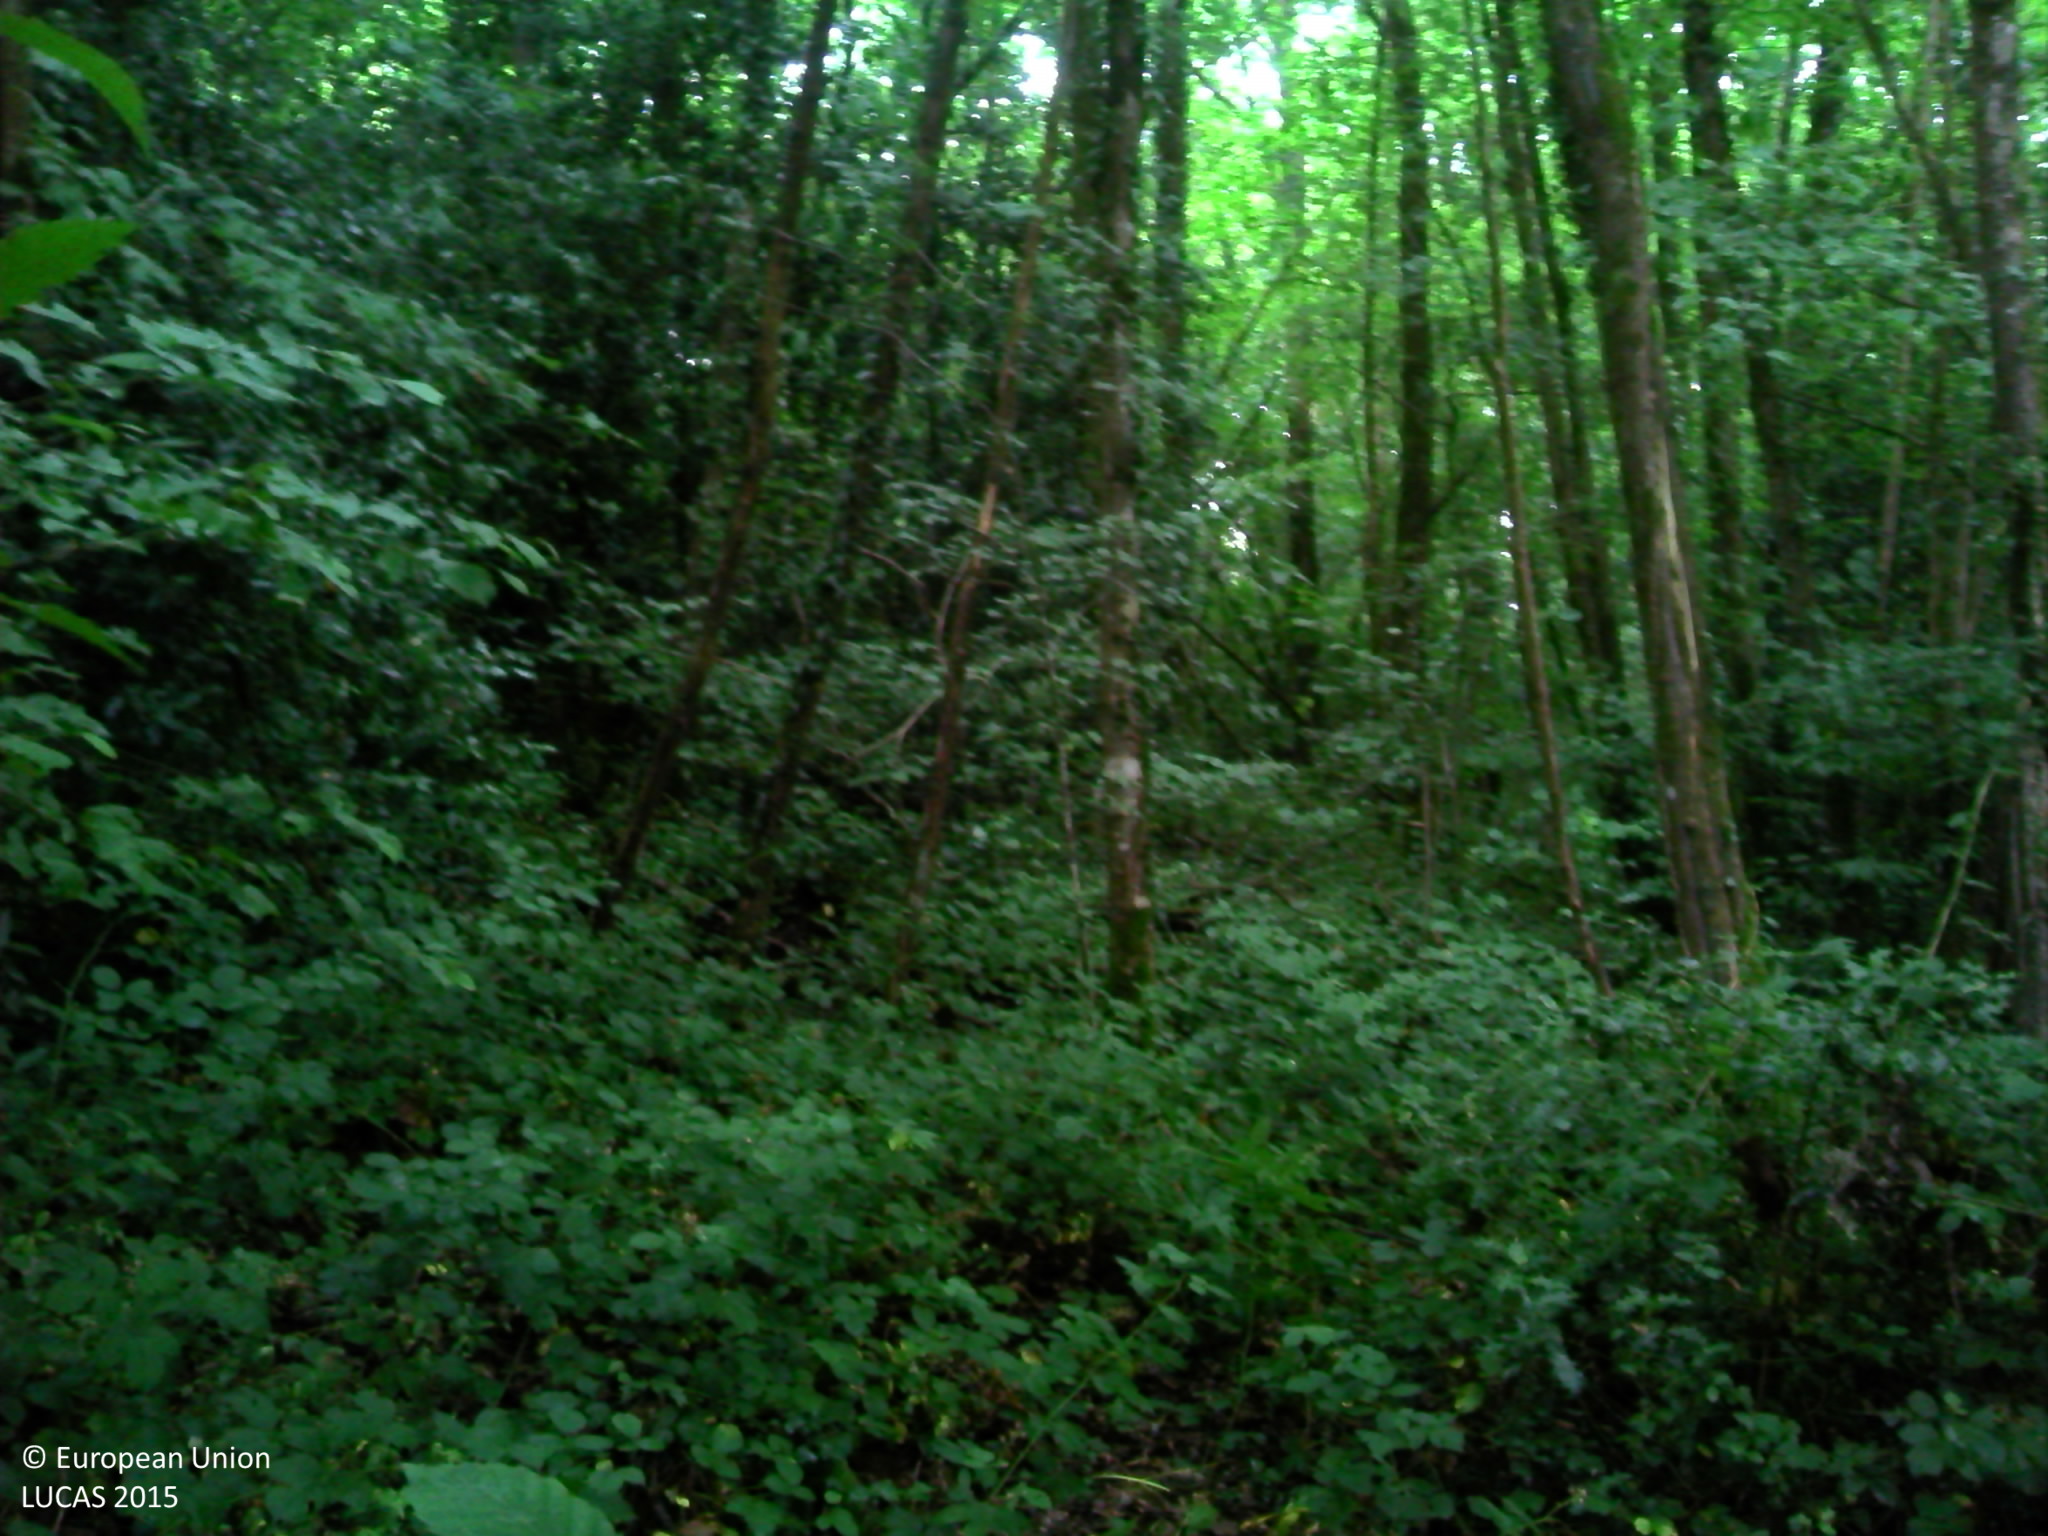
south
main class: Woodland
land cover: Broadleaved woodland
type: non-riverine alder, birch or aspen forest
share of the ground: > 75 %
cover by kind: broadleaved forest trees 95 %, herbaceous plants 5 %
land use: Semi-natural and natural areas not in use
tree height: > 5 m
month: July
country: FR
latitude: 47.1782
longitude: -1.8822
